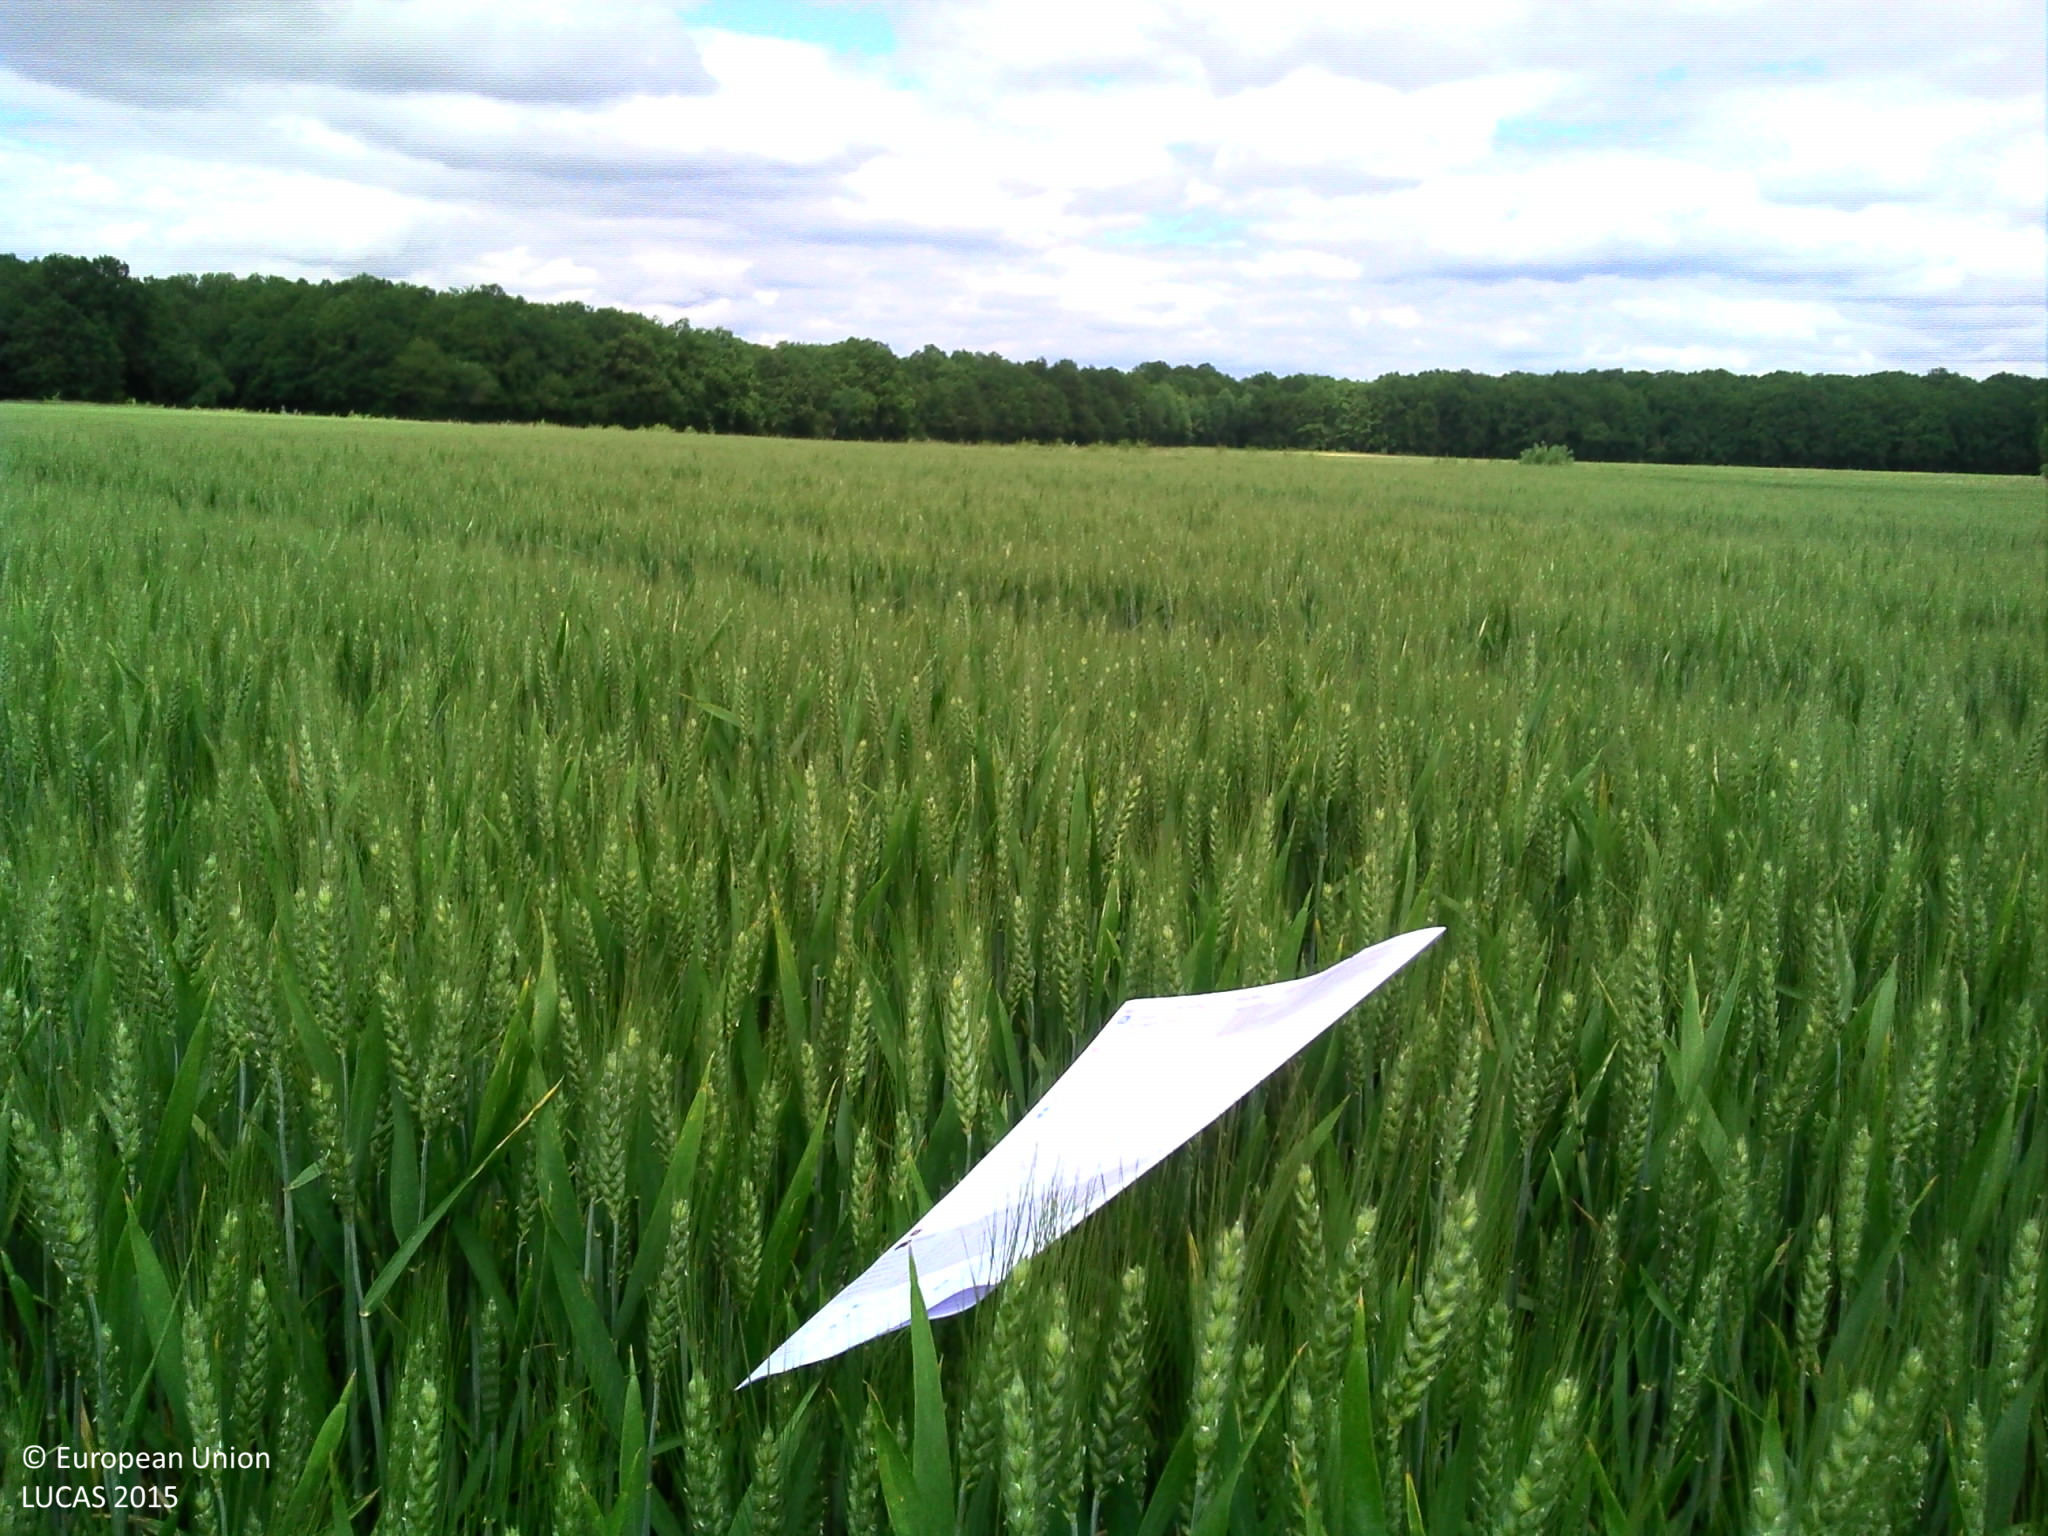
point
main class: Cropland
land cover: Durum wheat
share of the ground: > 75 %
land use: Agriculture (excluding fallow land and kitchen gardens)
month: June
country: FR
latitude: 48.5123
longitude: 4.7319
